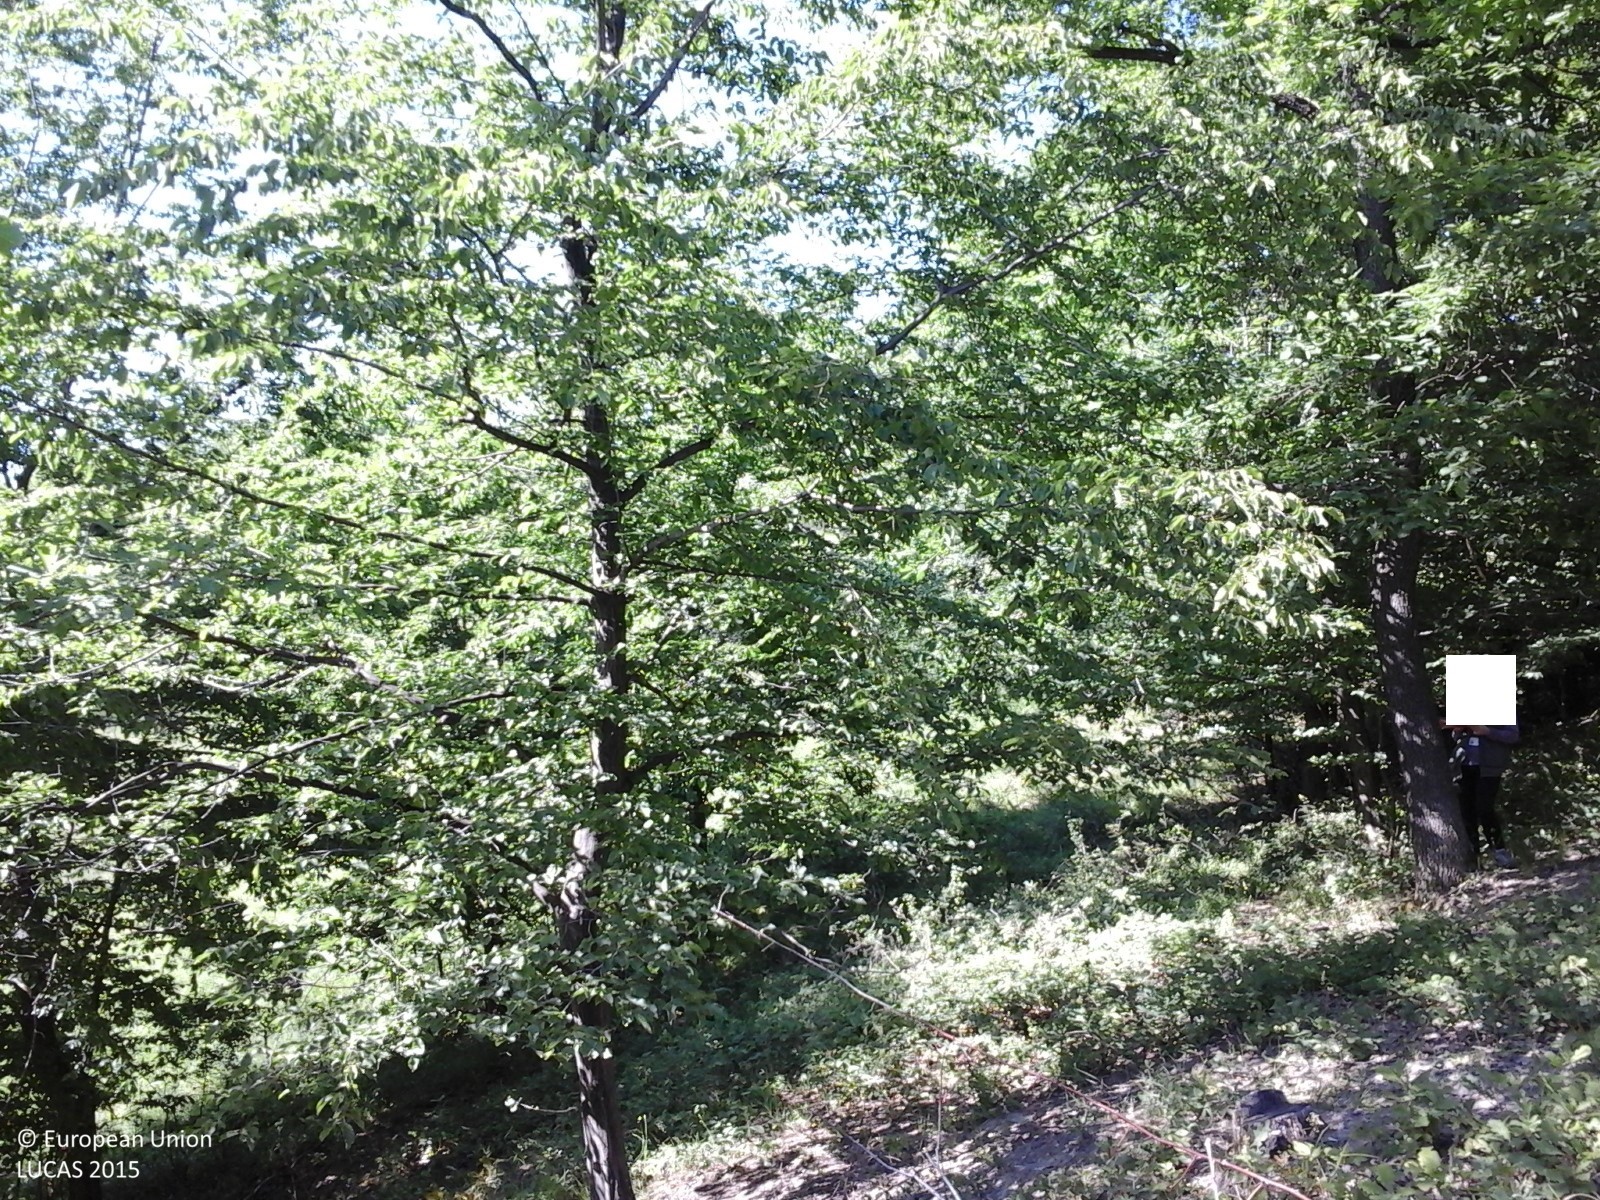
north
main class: Woodland
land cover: Broadleaved woodland
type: acidophilous oak and oak-birch forest
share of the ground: > 75 %
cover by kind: broadleaved forest trees 90 %, shrubs 10 %
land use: Forestry
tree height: > 5 m
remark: Clear cut
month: June
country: RO
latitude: 45.1297
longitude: 25.8073
